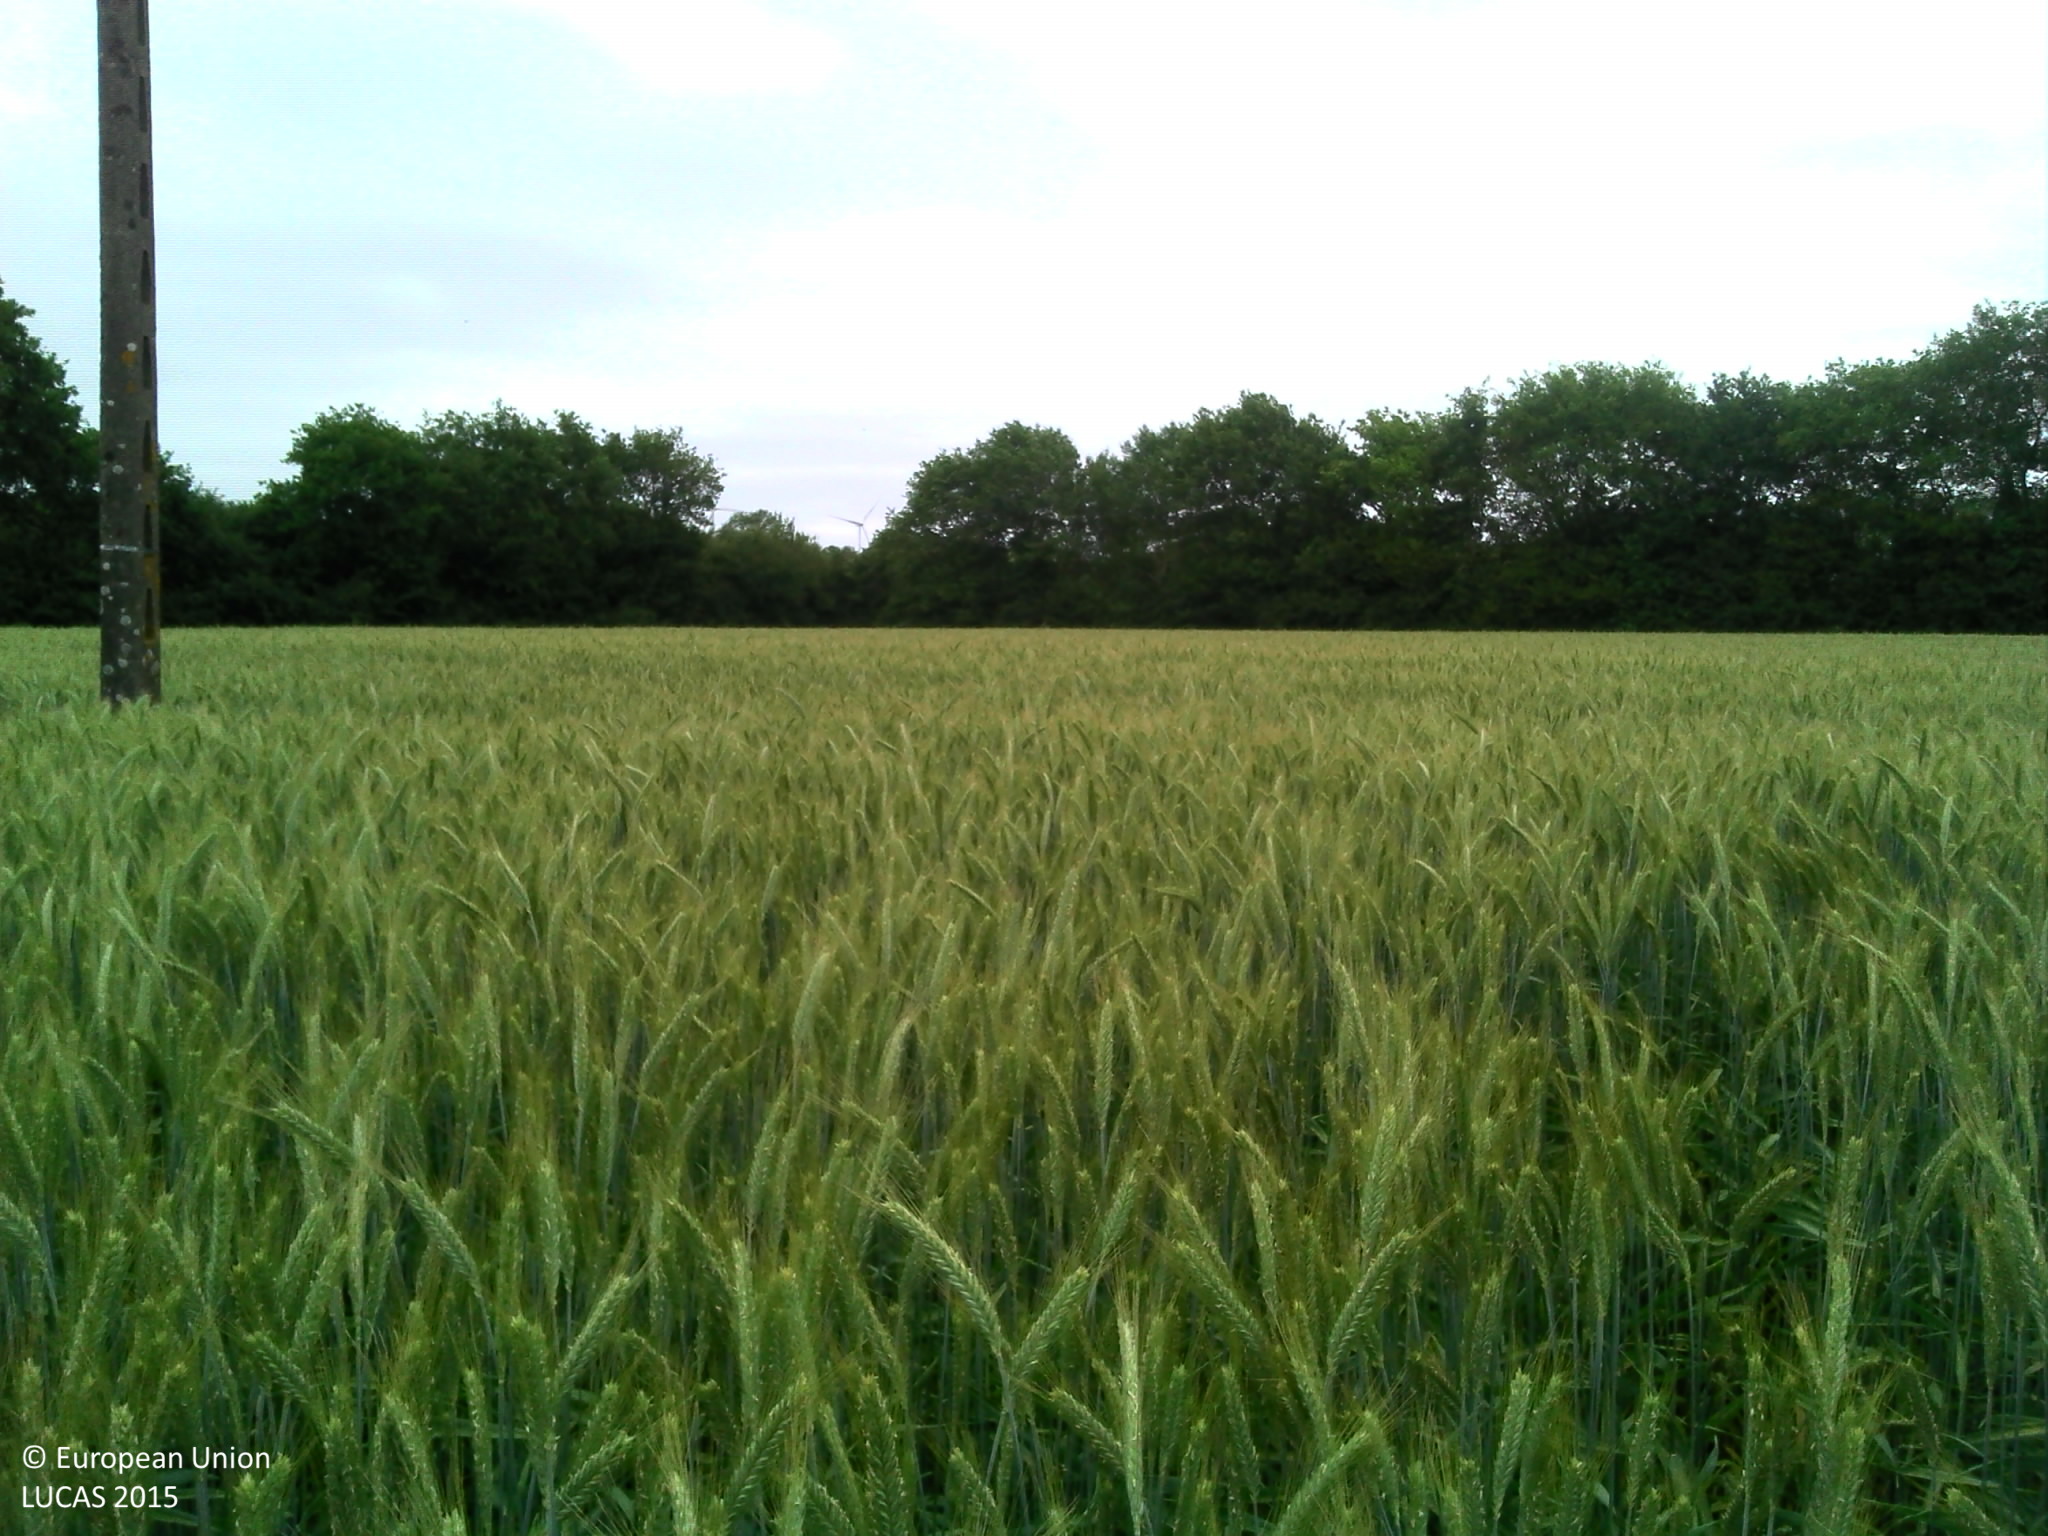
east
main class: Cropland
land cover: Triticale
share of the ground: > 75 %
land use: Agriculture (excluding fallow land and kitchen gardens)
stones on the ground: < 10 %
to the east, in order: Triticale; Electric lines; Triticale; Lines of trees; Triticale; Lines of trees; Grassland without tree/shrub cover; Managed hedges; Ditches and canals; Other bare soil
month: June
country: FR
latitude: 46.8794
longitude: -1.7874
